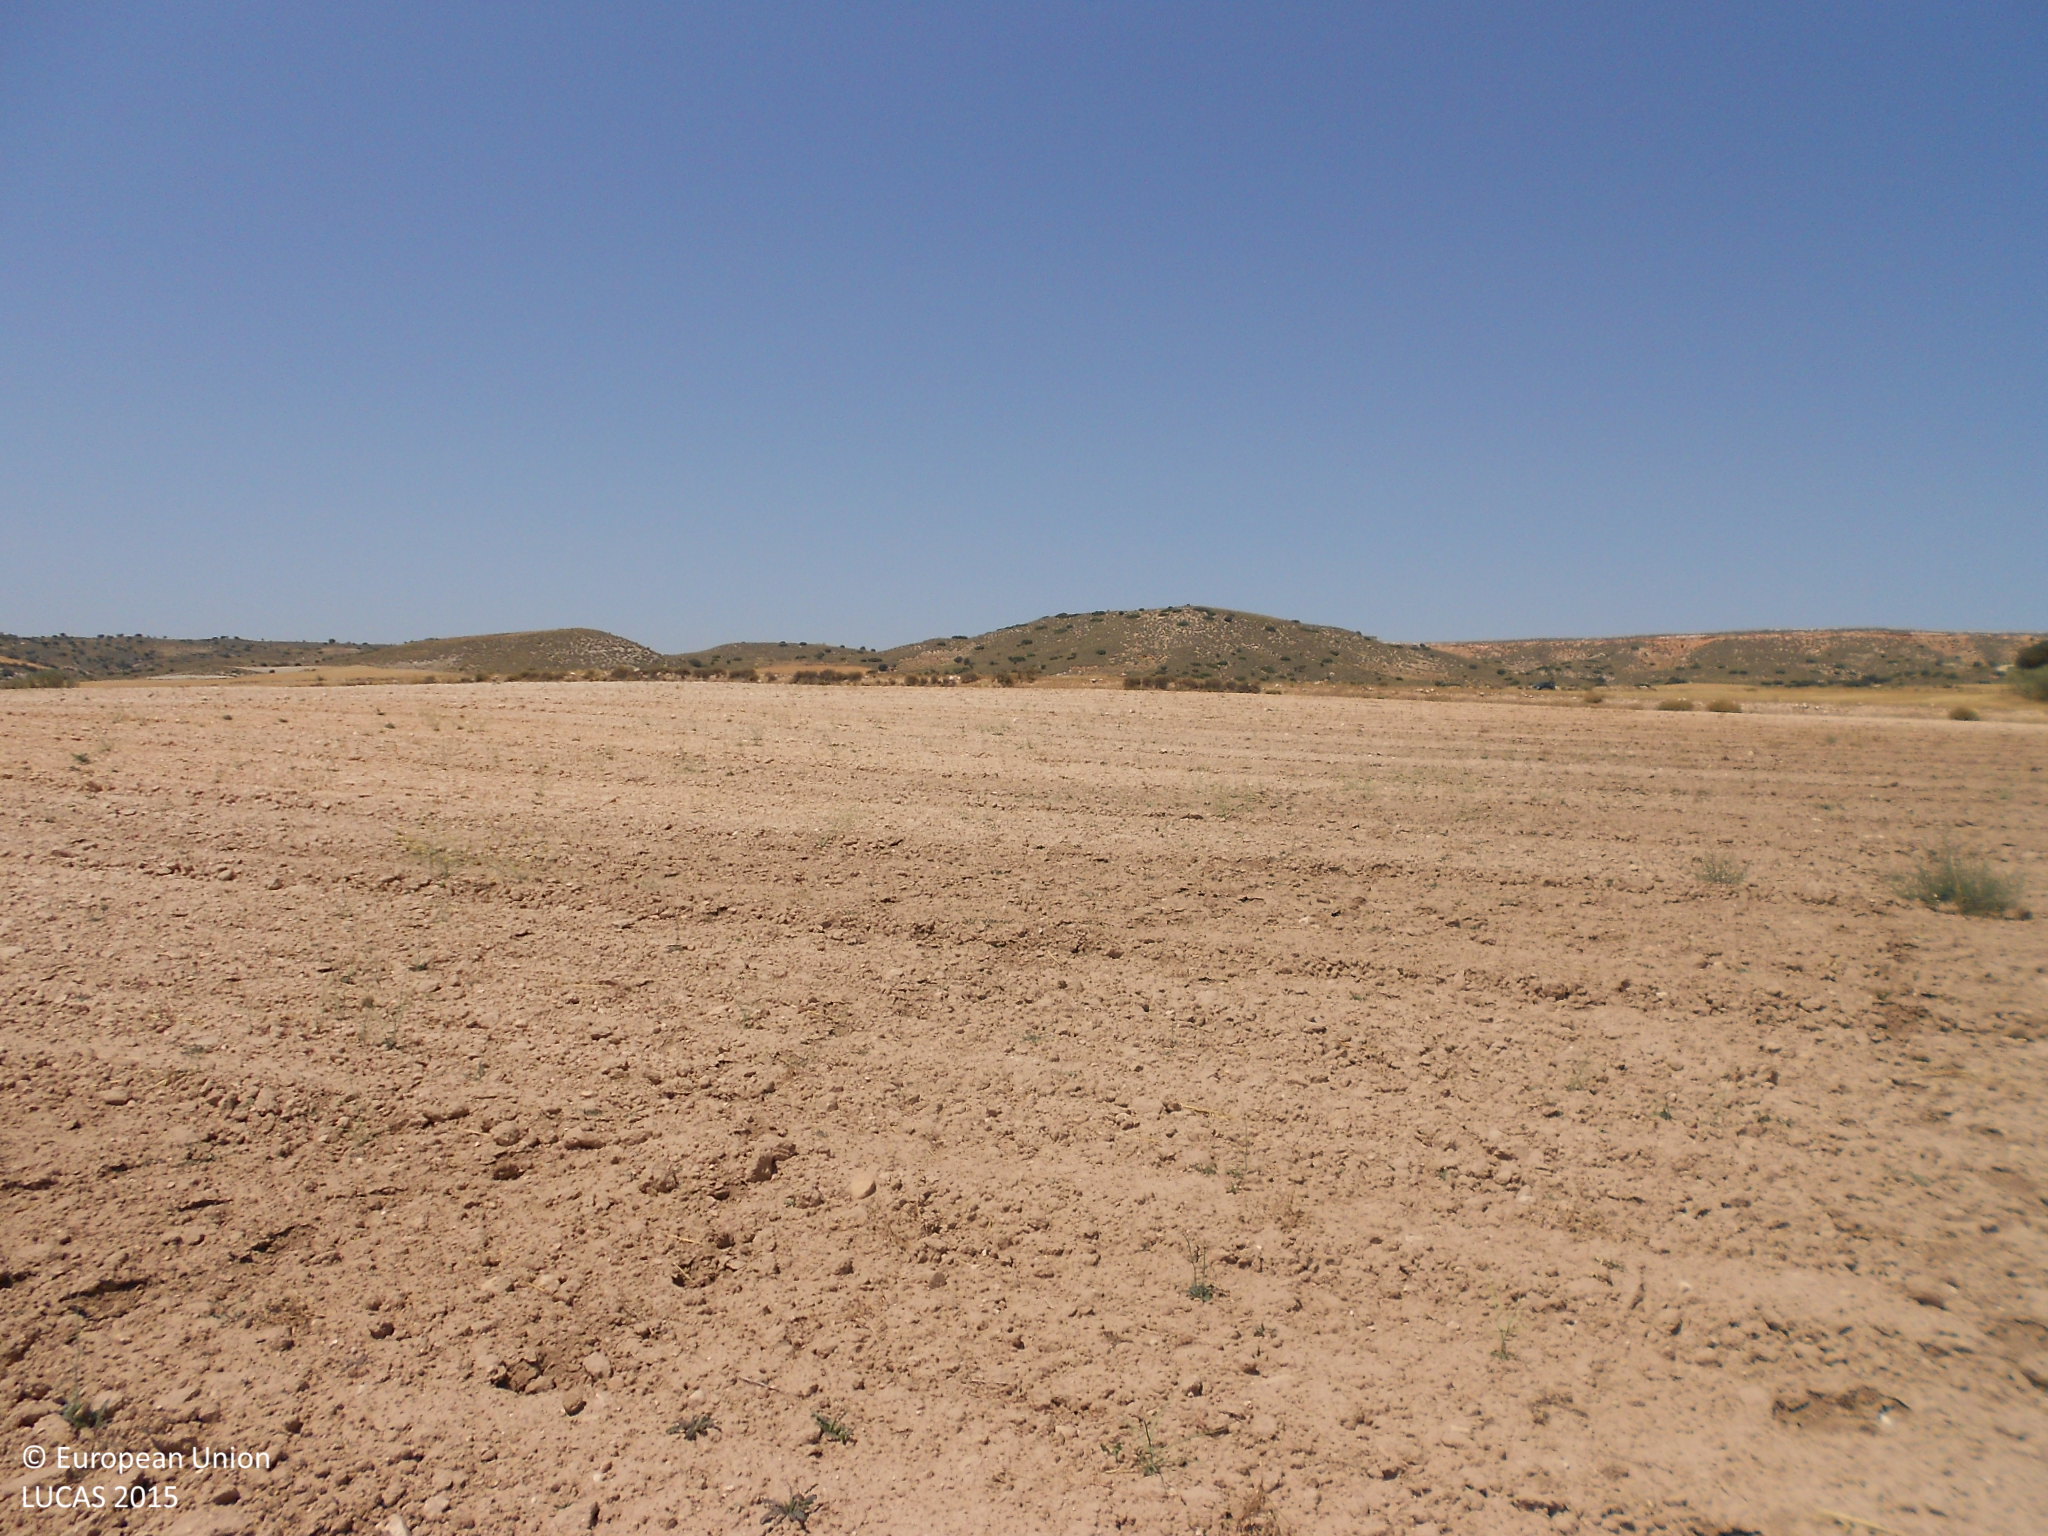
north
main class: Grassland
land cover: Spontaneously vegetated surfaces
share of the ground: 25 - 50 %
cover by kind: consolidated bare surface 60 %, herbaceous plants 40 %
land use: Fallow land
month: August
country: ES
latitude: 37.7366
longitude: -2.2763
